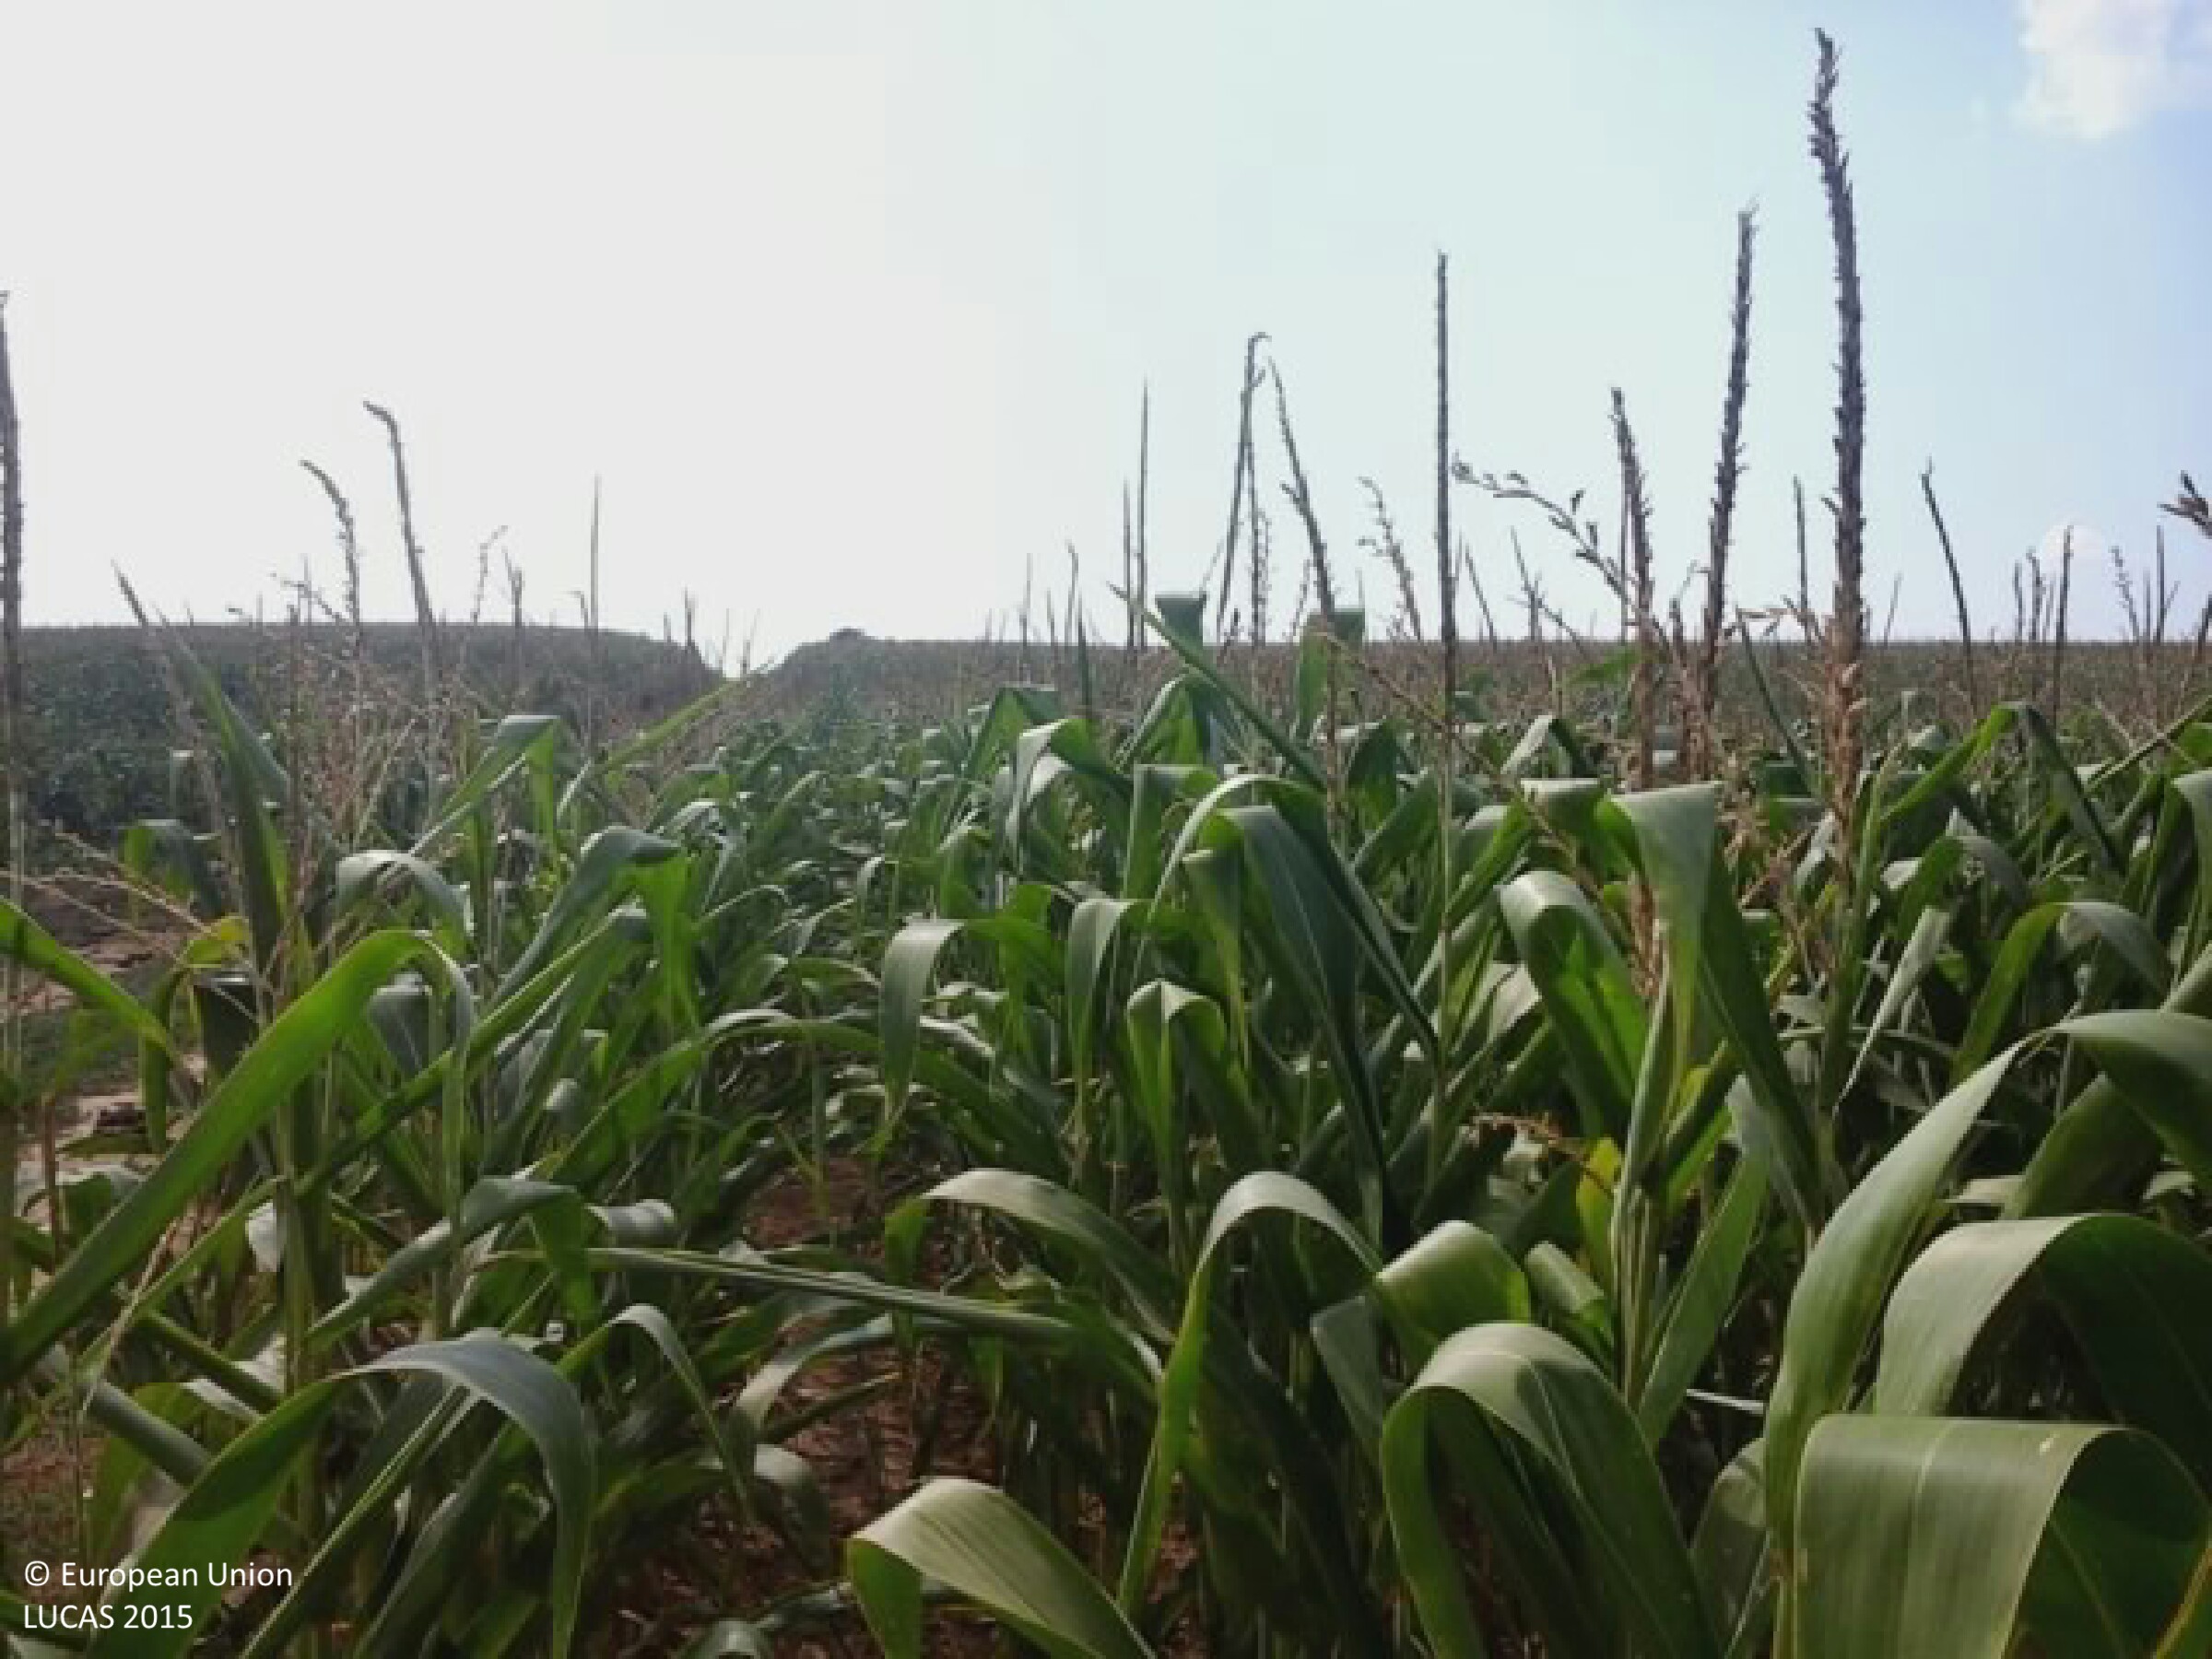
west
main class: Cropland
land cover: Maize
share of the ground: > 75 %
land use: Agriculture (excluding fallow land and kitchen gardens)
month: August
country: HU
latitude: 46.3233
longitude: 18.2296
